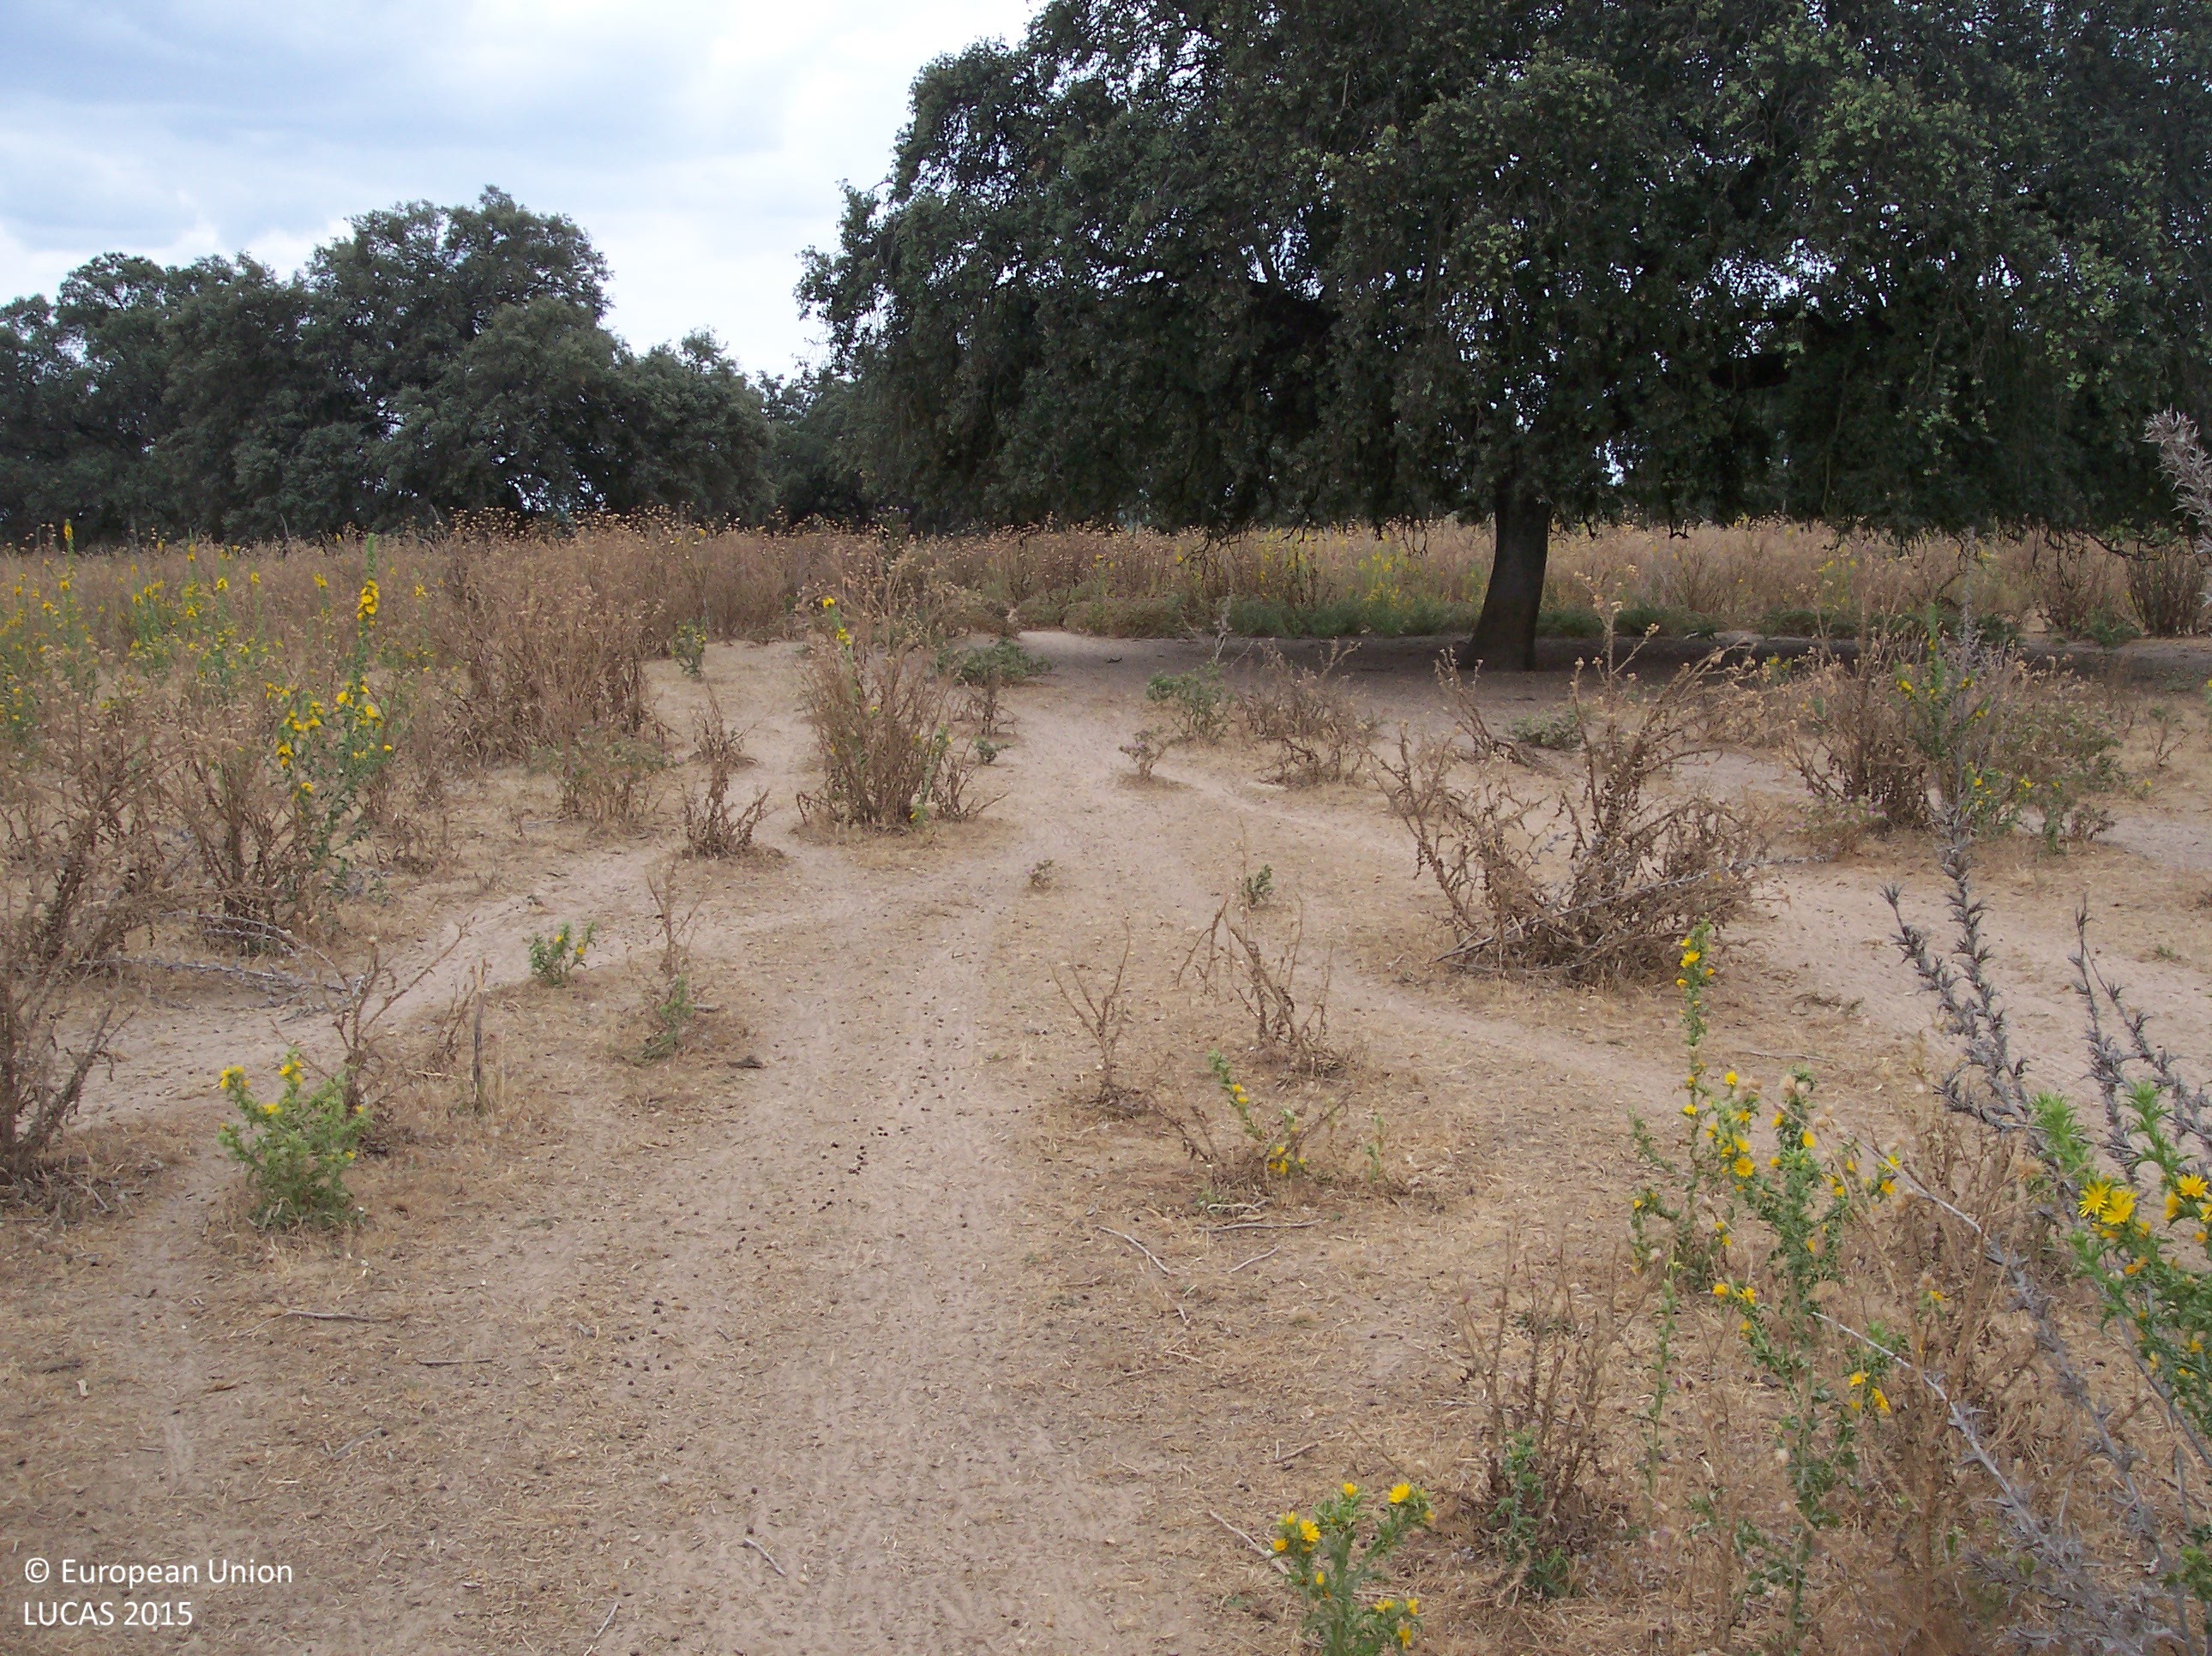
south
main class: Shrubland
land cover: Shrubland with sparse tree cover
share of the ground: 25 - 50 %
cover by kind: unconsolidated bare surface 60 %, shrubs 20 %, herbaceous plants 15 %, broadleaved forest trees 5 %
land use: Agriculture (excluding fallow land and kitchen gardens)
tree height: > 5 m
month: June
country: ES
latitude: 37.3273
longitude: -6.4049
